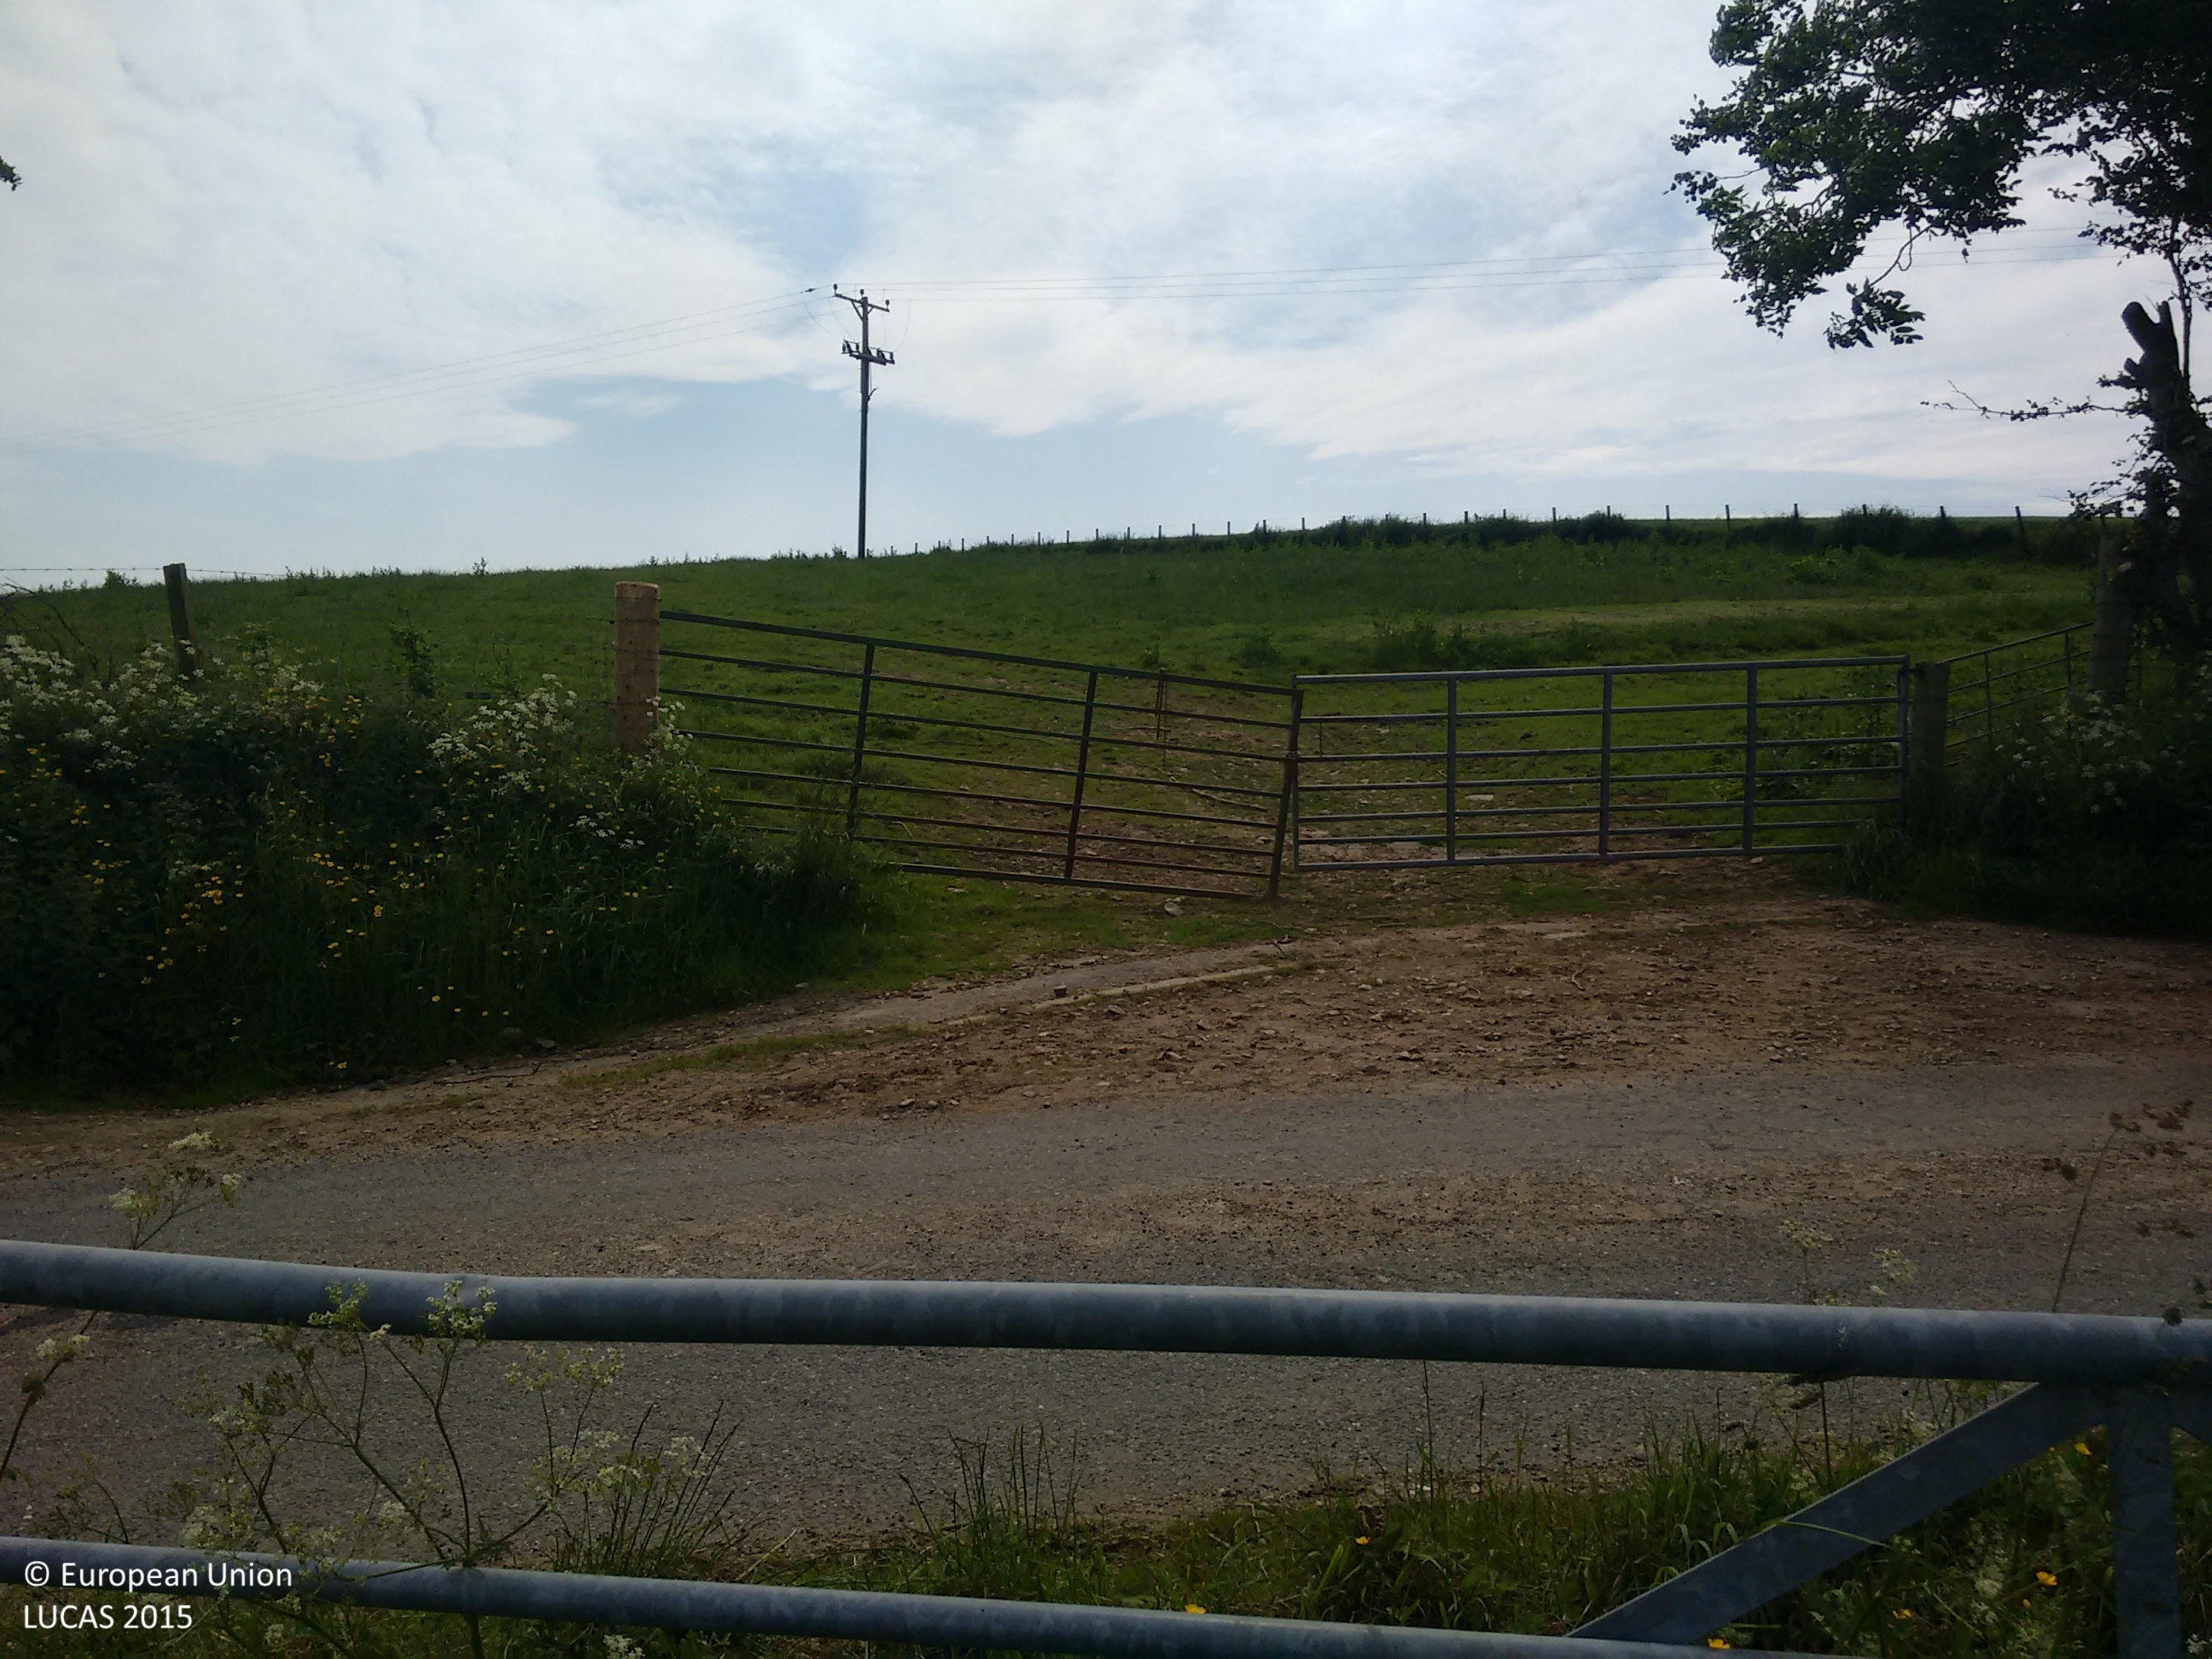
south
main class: Grassland
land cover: Grassland without tree/shrub cover
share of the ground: > 75 %
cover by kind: herbaceous plants 100 %
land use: Agriculture (excluding fallow land and kitchen gardens)
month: July
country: GB
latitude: 57.4397
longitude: -2.8028
